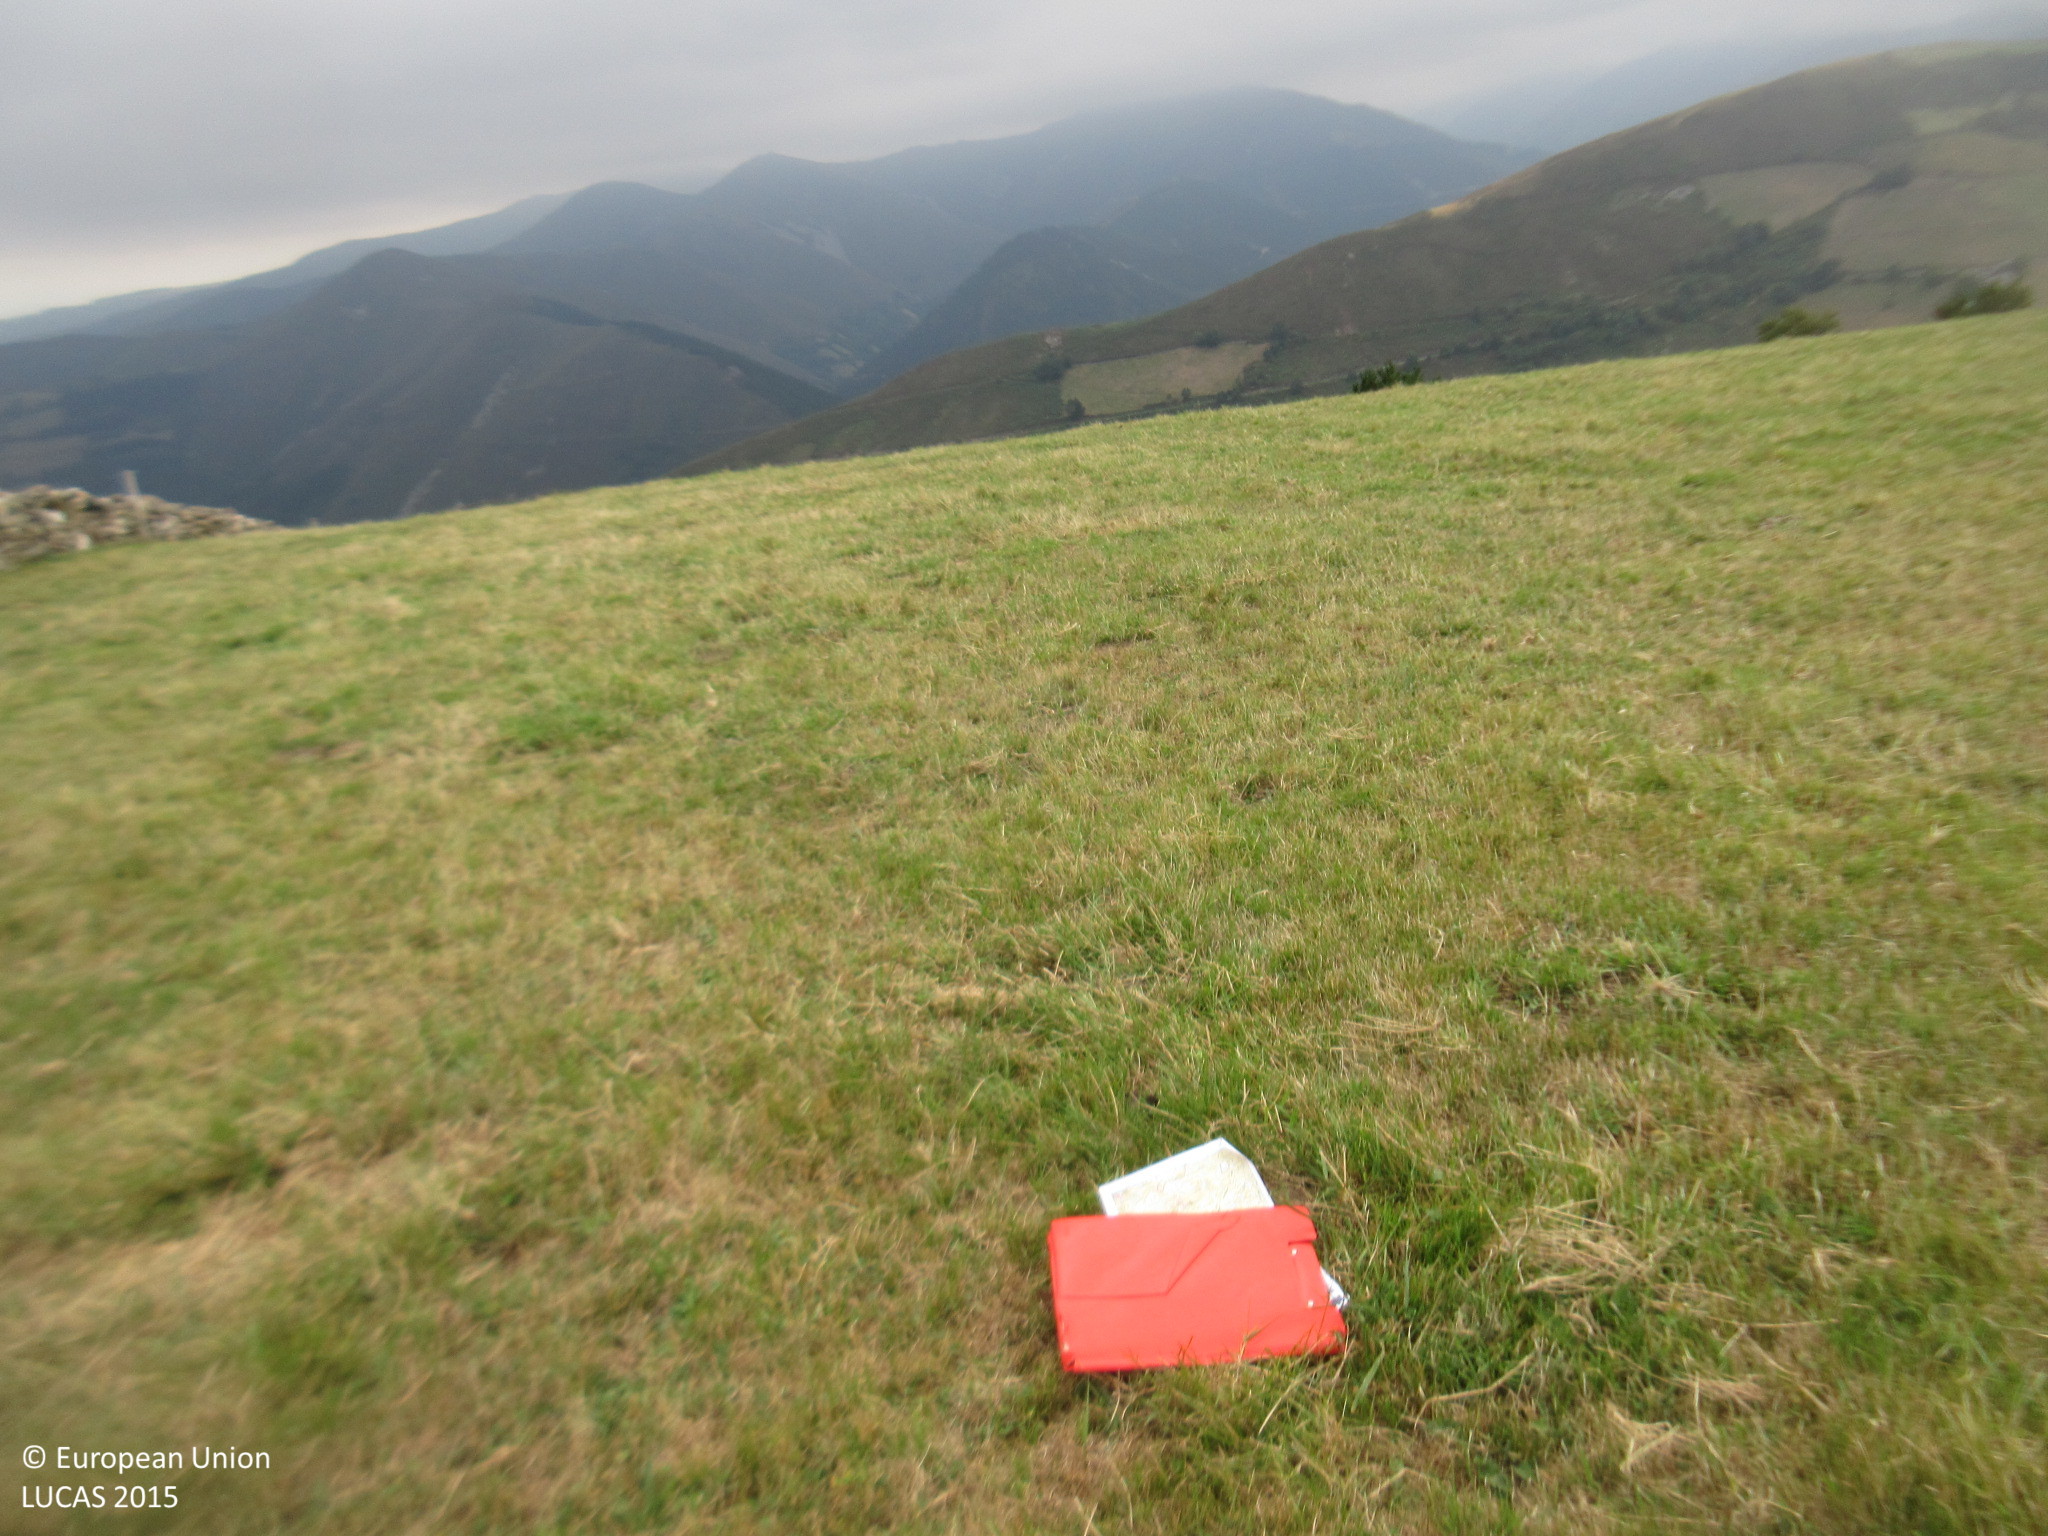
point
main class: Grassland
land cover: Grassland without tree/shrub cover
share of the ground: > 75 %
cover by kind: herbaceous plants 100 %
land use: Agriculture (excluding fallow land and kitchen gardens)
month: August
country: ES
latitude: 43.4256
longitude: -6.5965
